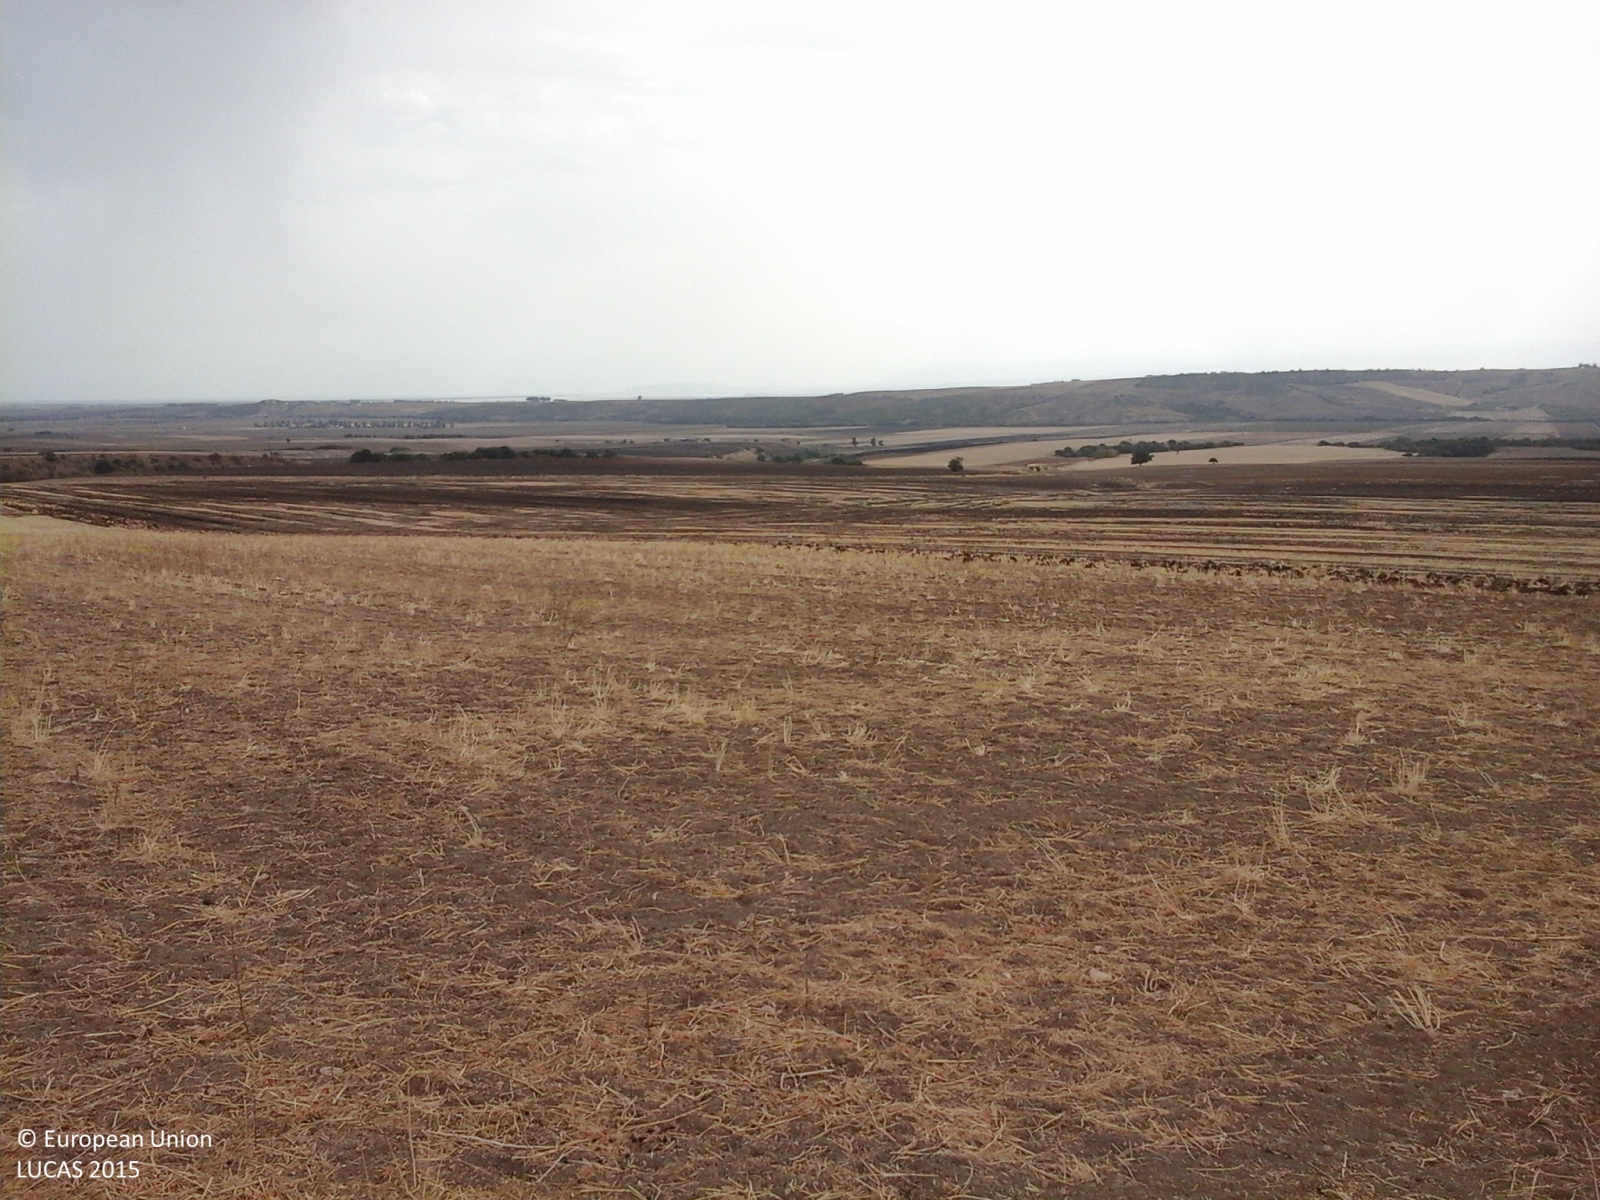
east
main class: Cropland
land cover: Other non-permanent industrial crops
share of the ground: > 75 %
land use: Agriculture (excluding fallow land and kitchen gardens)
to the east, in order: Other non-permanent industrial crops; Durum wheat
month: September
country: IT
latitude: 41.8328
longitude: 15.1978
